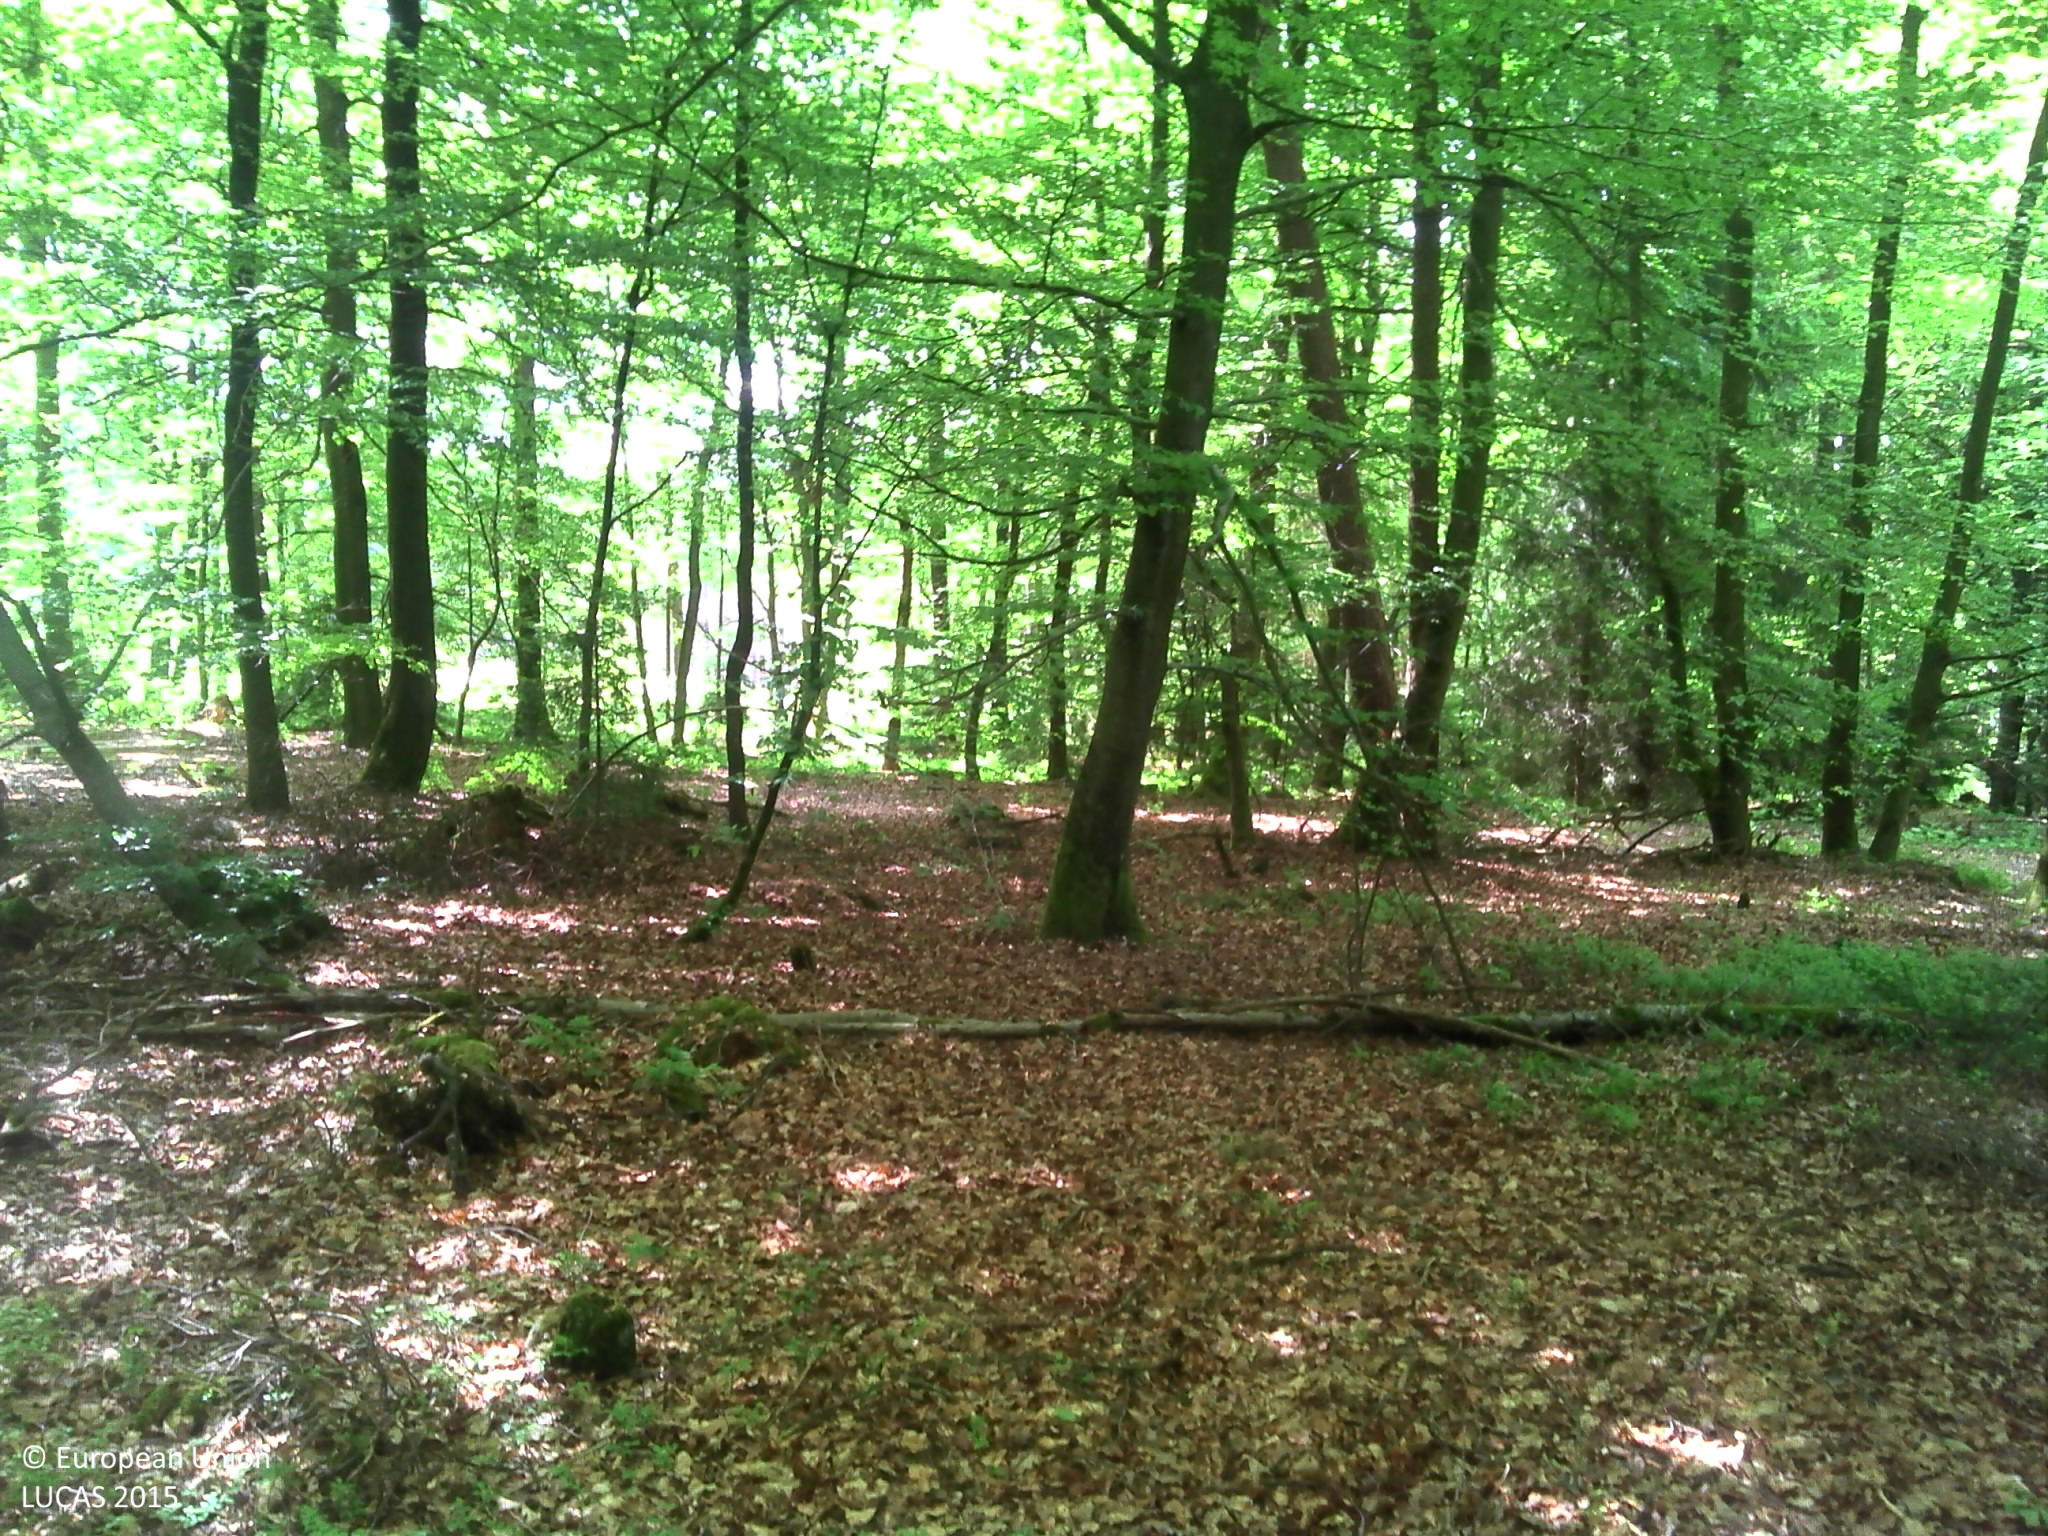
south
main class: Woodland
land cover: Broadleaved woodland
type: acidophilous oak and oak-birch forest
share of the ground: > 75 %
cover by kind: broadleaved forest trees 90 %, coniferous forest trees 5 %, herbaceous plants 5 %
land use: Forestry
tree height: > 5 m
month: May
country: LU
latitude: 49.8424
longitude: 5.9526
